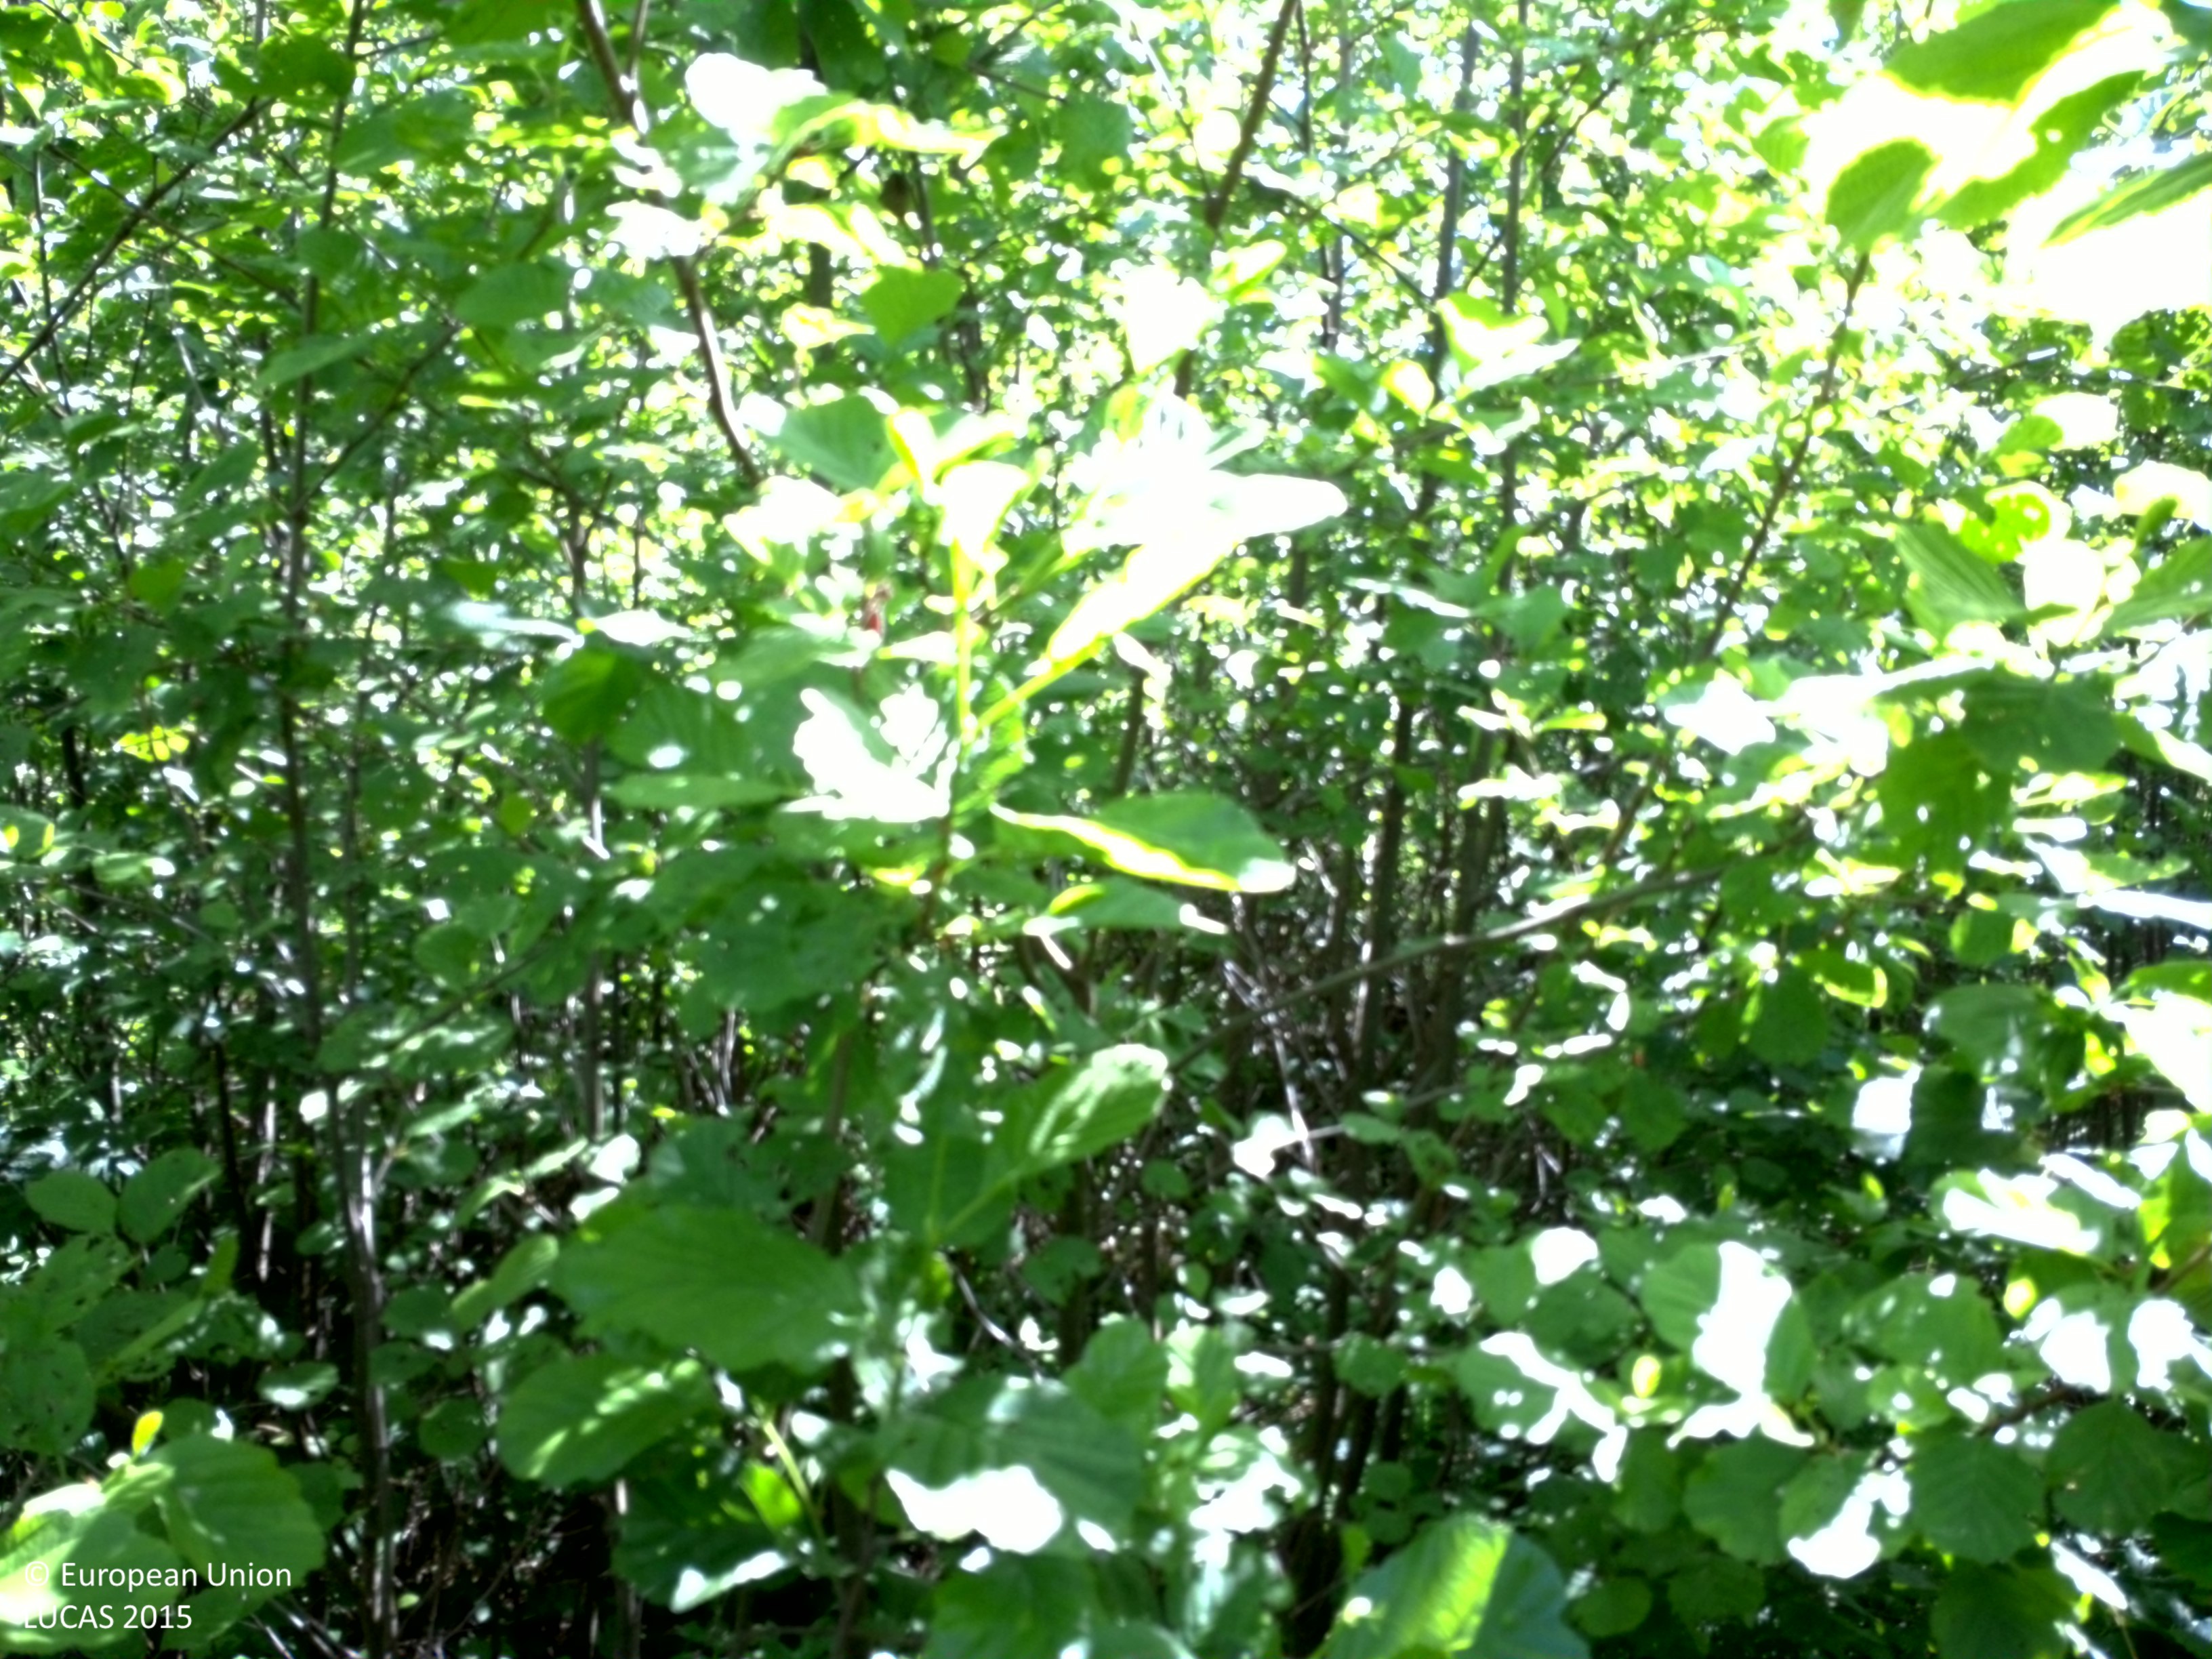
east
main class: Woodland
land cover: Broadleaved woodland
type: hemiboreal forest and nemoral coniferous forest and mixed broadleaved-coniferous forest
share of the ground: > 75 %
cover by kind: broadleaved forest trees 95 %, herbaceous plants 5 %
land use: Forestry
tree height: < 5 m
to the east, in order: Broadleaved woodland; Ditches and canals; Broadleaved woodland; Dry stone walls; Spruce dominated mixed woodland; Fences; Spruce dominated mixed woodland; Spruce dominated coniferous woodland; Broadleaved woodland; Spruce dominated coniferous woodland; Spruce dominated mixed woodland
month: June
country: SE
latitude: 58.6367
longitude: 14.3170
